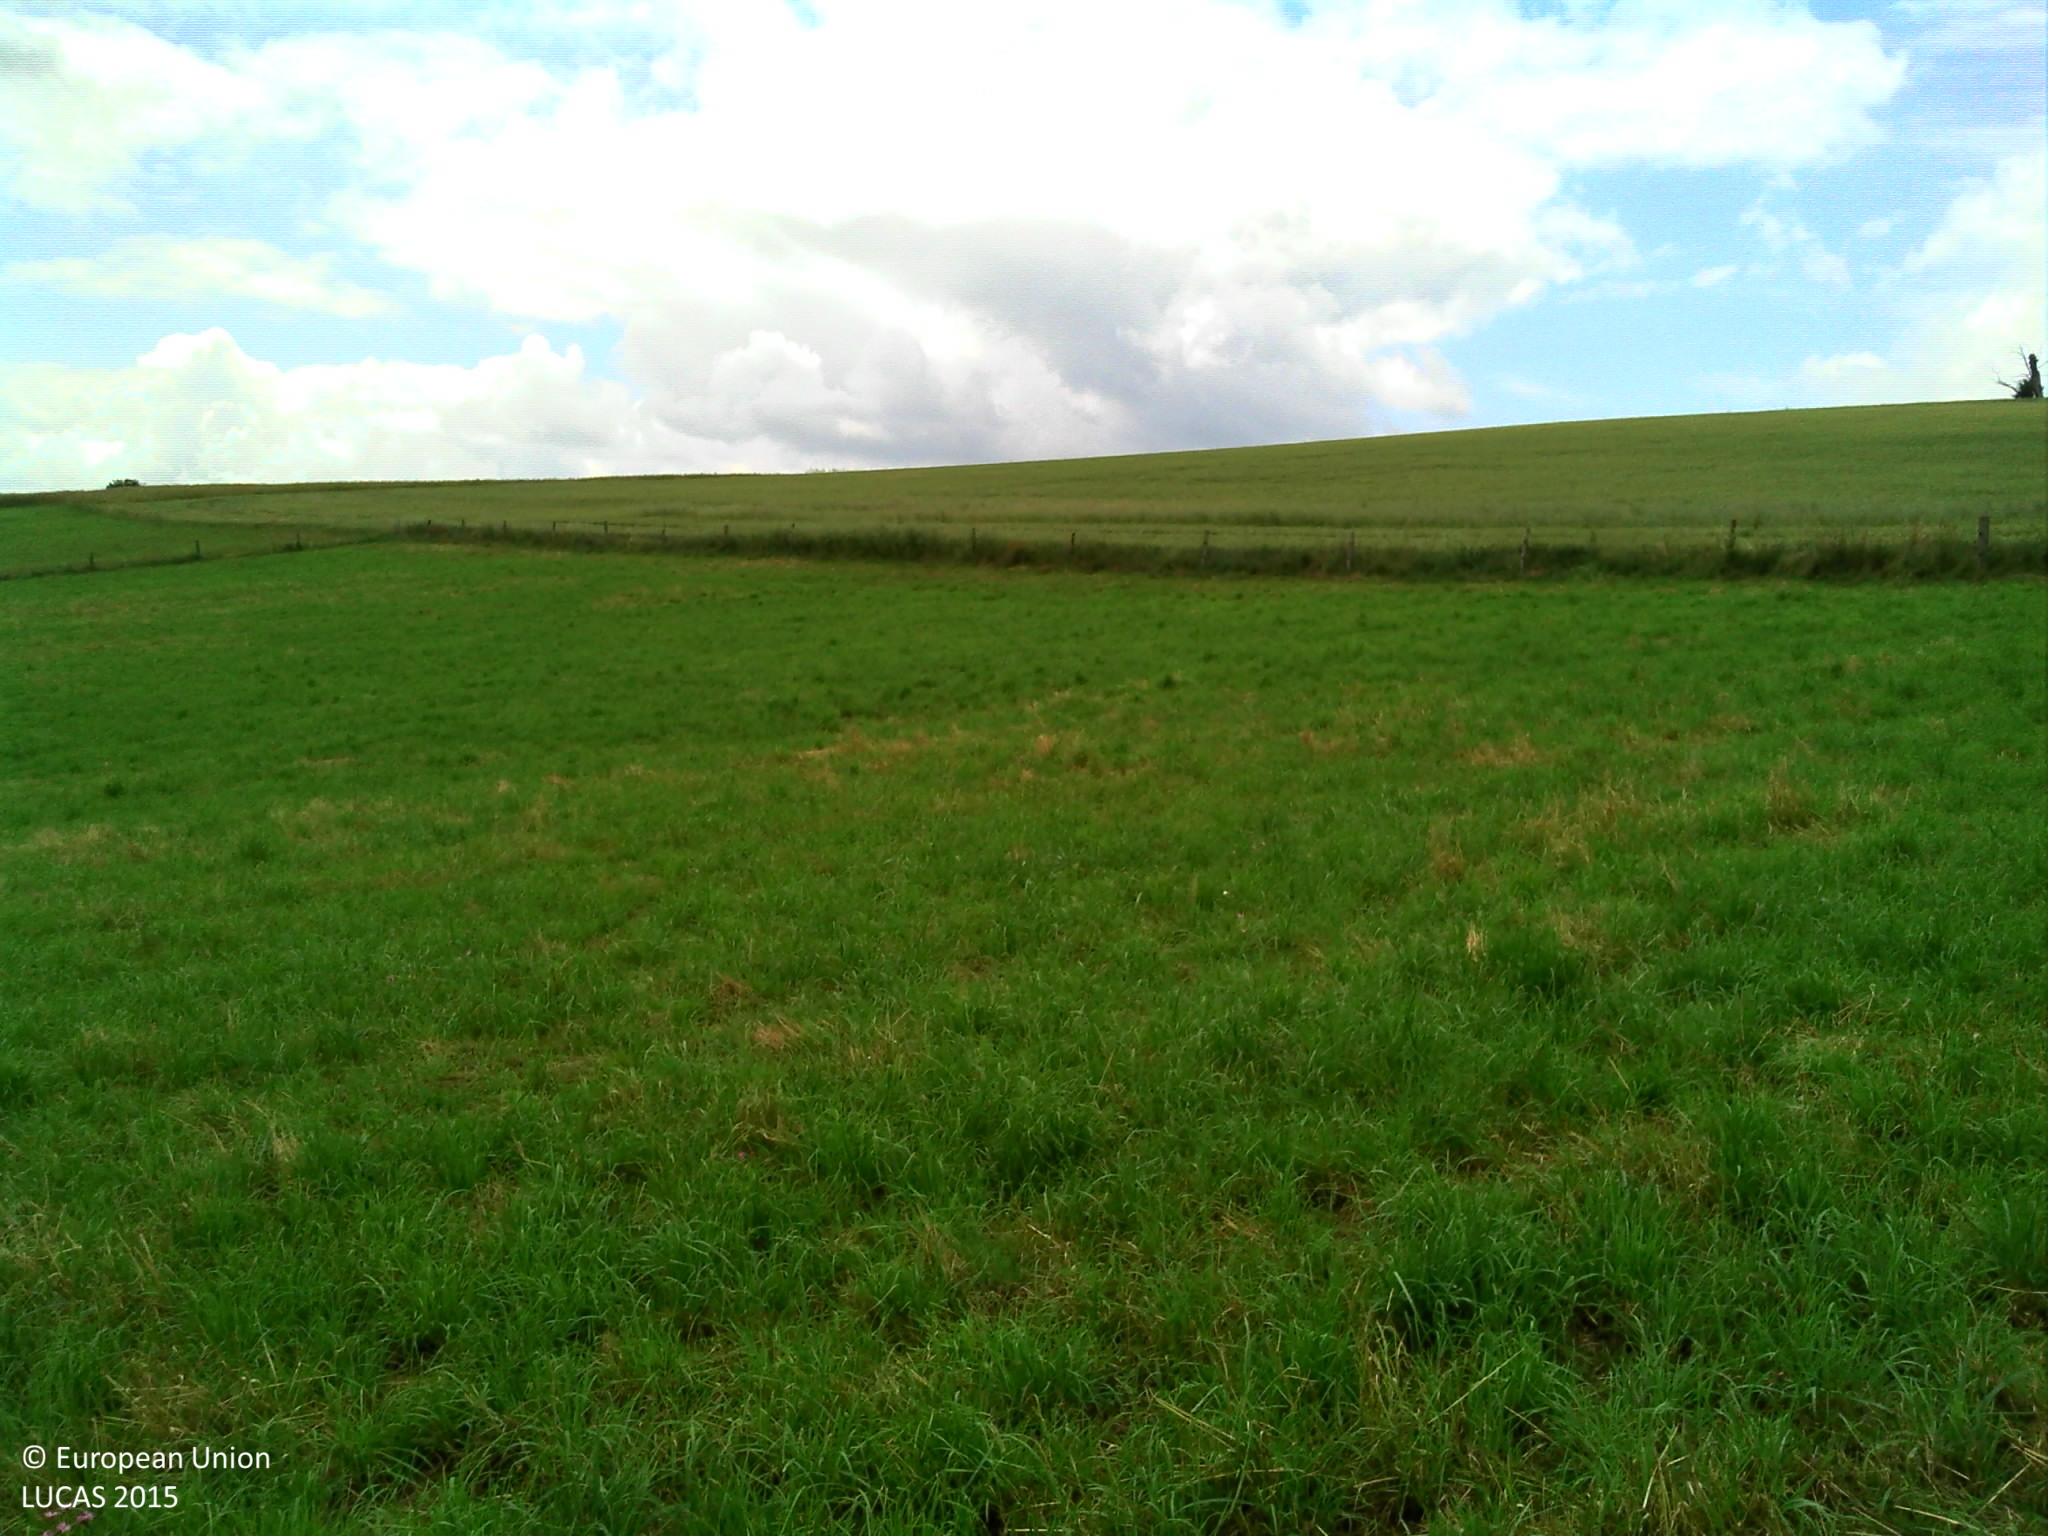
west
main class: Cropland
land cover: Temporary grasslands
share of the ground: > 75 %
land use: Agriculture (excluding fallow land and kitchen gardens)
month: June
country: FR
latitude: 44.2421
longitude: 2.5030
